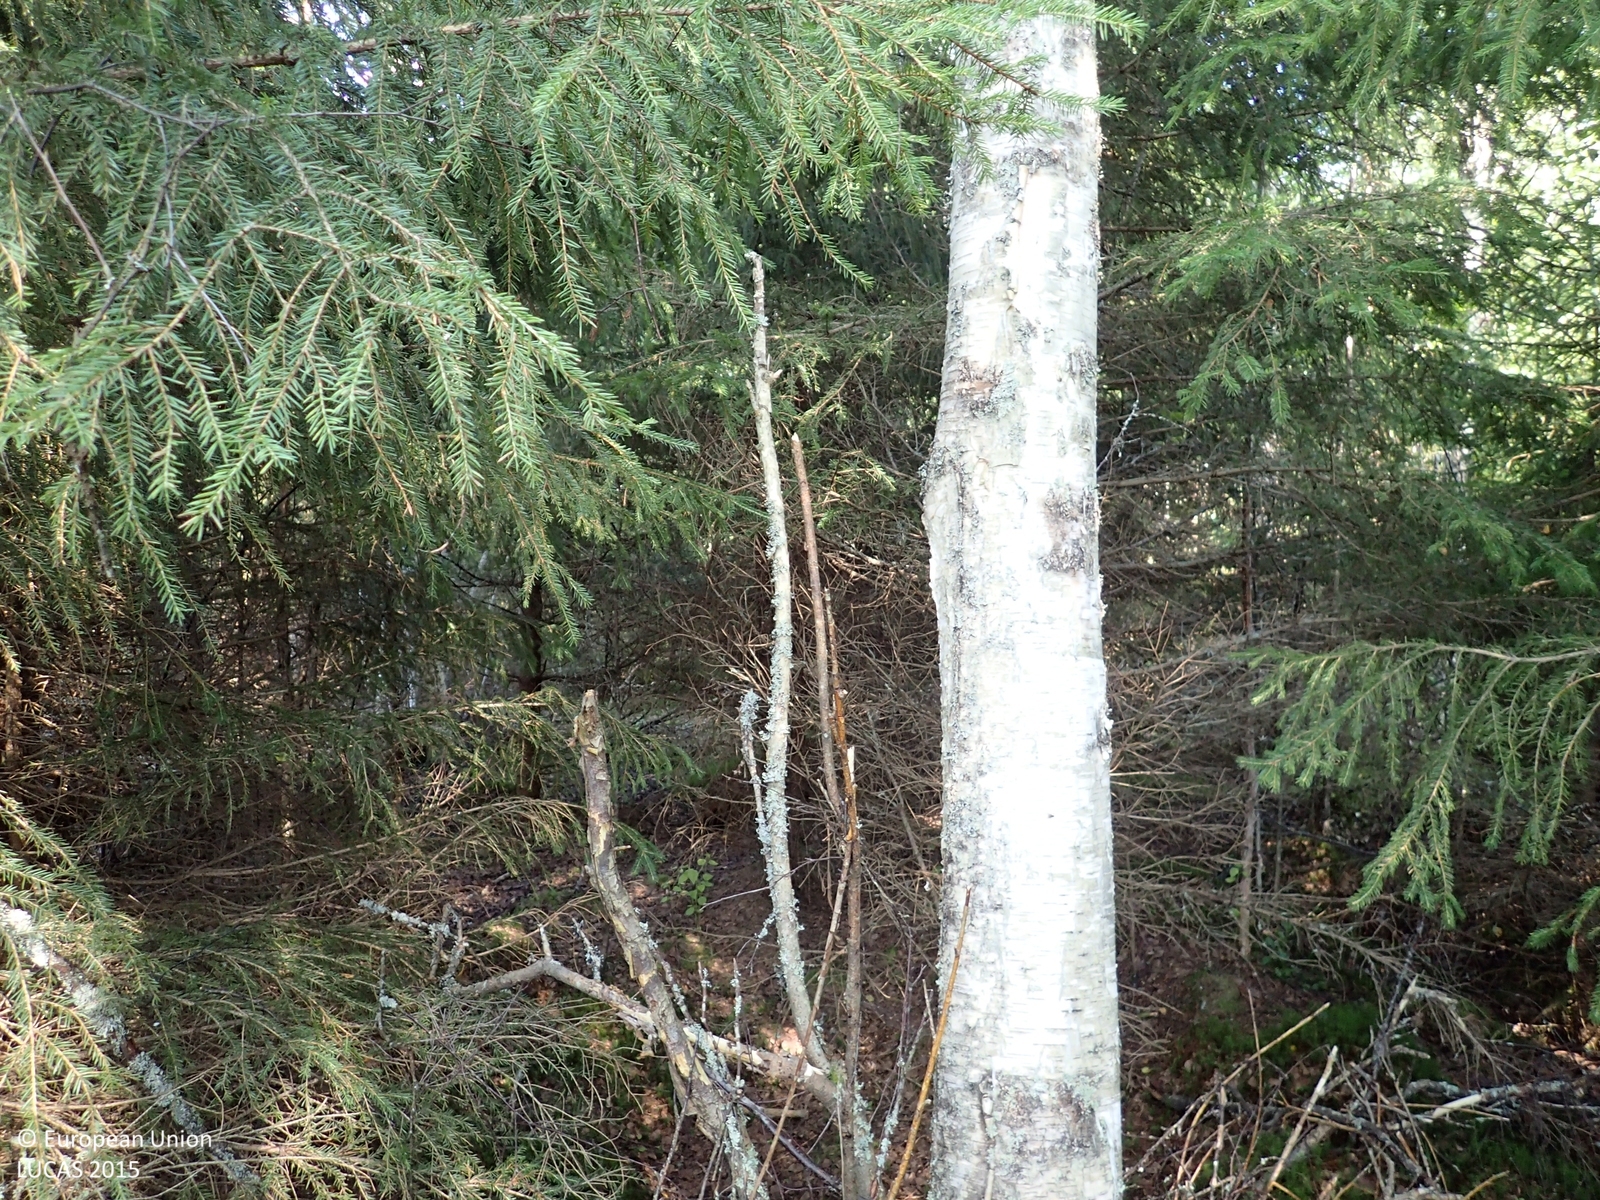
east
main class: Woodland
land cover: Spruce dominated mixed woodland
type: boreal forest
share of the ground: > 75 %
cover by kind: coniferous forest trees 50 %, broadleaved forest trees 30 %, shrubs 10 %, lichens and mosses 10 %
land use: Forestry
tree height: > 5 m
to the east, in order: Spruce dominated mixed woodland; Grassland without tree/shrub cover; Ditches and canals; Spruce dominated mixed woodland; Ditches and canals; Spruce dominated mixed woodland; Ditches and canals; Other bare soil; Ditches and canals; Other bare soil; Broadleaved woodland; Ditches and canals; Spruce dominated mixed woodland; Ditches and canals; Other coniferous woodland; Ditches and canals; Spruce dominated mixed woodland
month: August
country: FI
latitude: 62.6450
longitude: 21.9666
